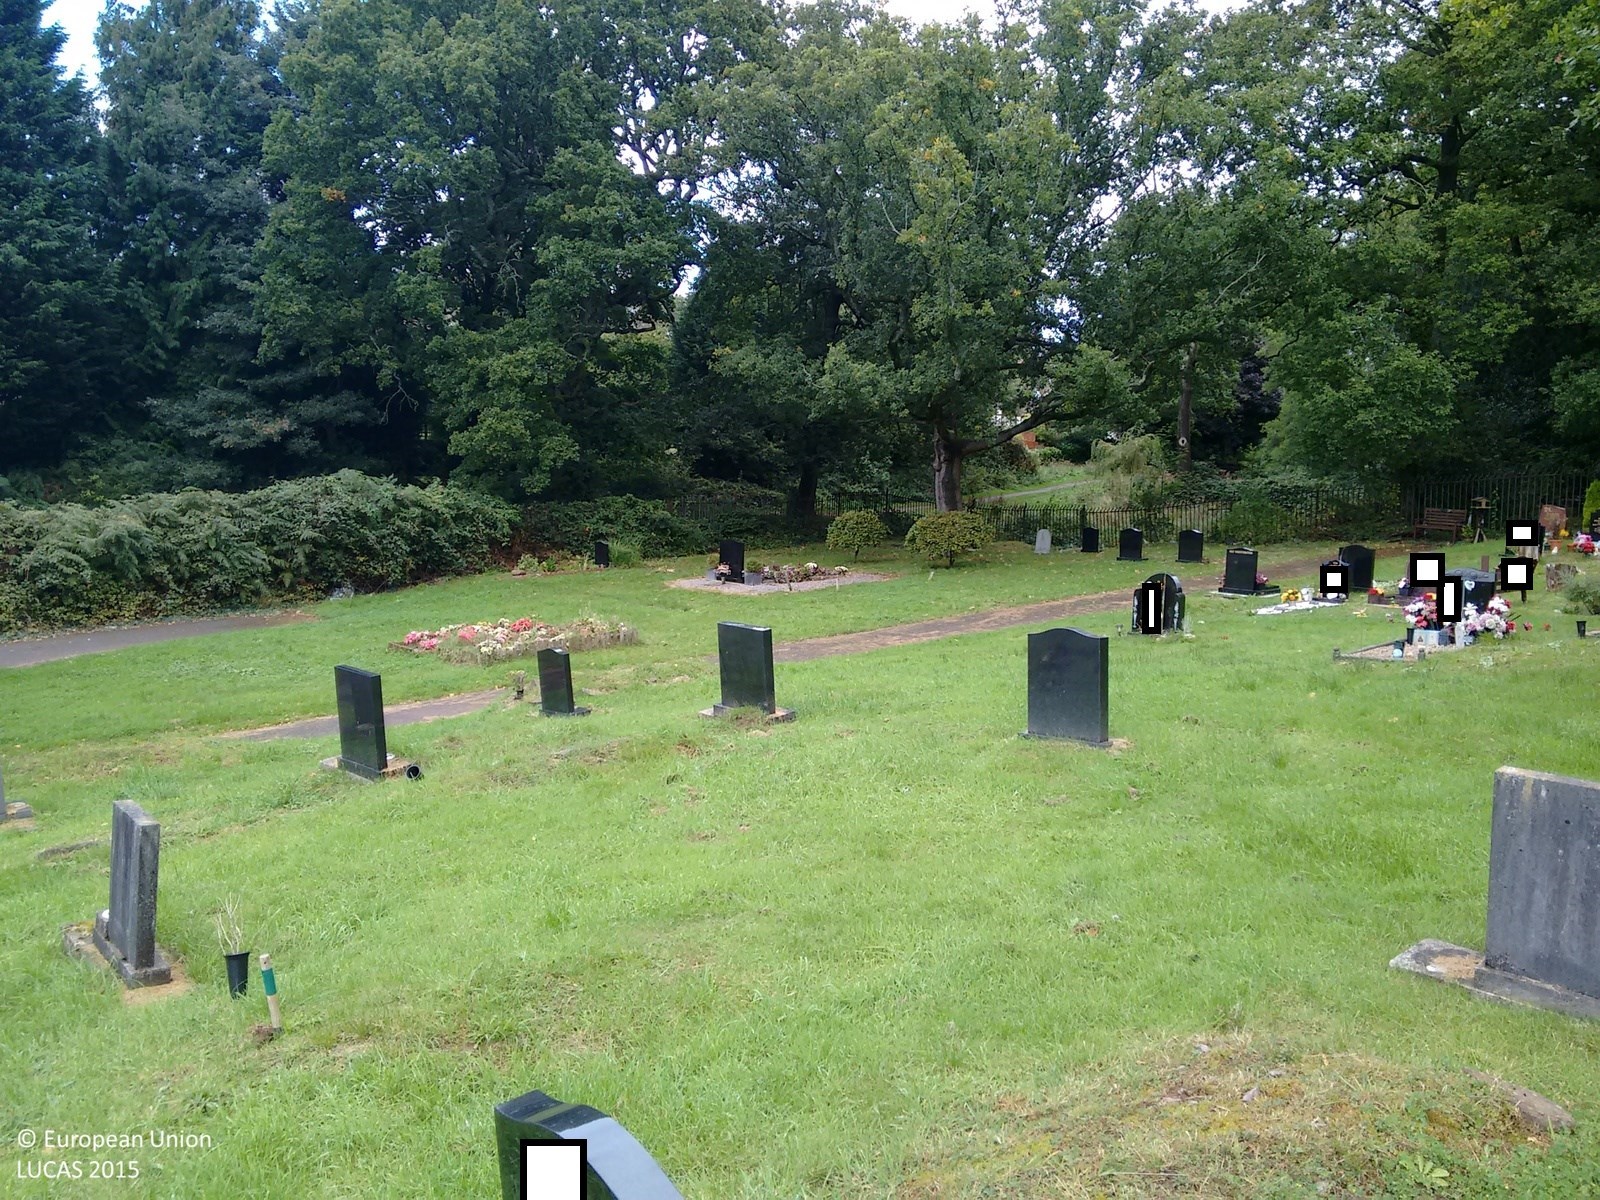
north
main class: Grassland
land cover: Grassland without tree/shrub cover
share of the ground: > 75 %
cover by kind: herbaceous plants 100 %
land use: Community services
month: September
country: GB
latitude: 51.5835
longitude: -3.0210
